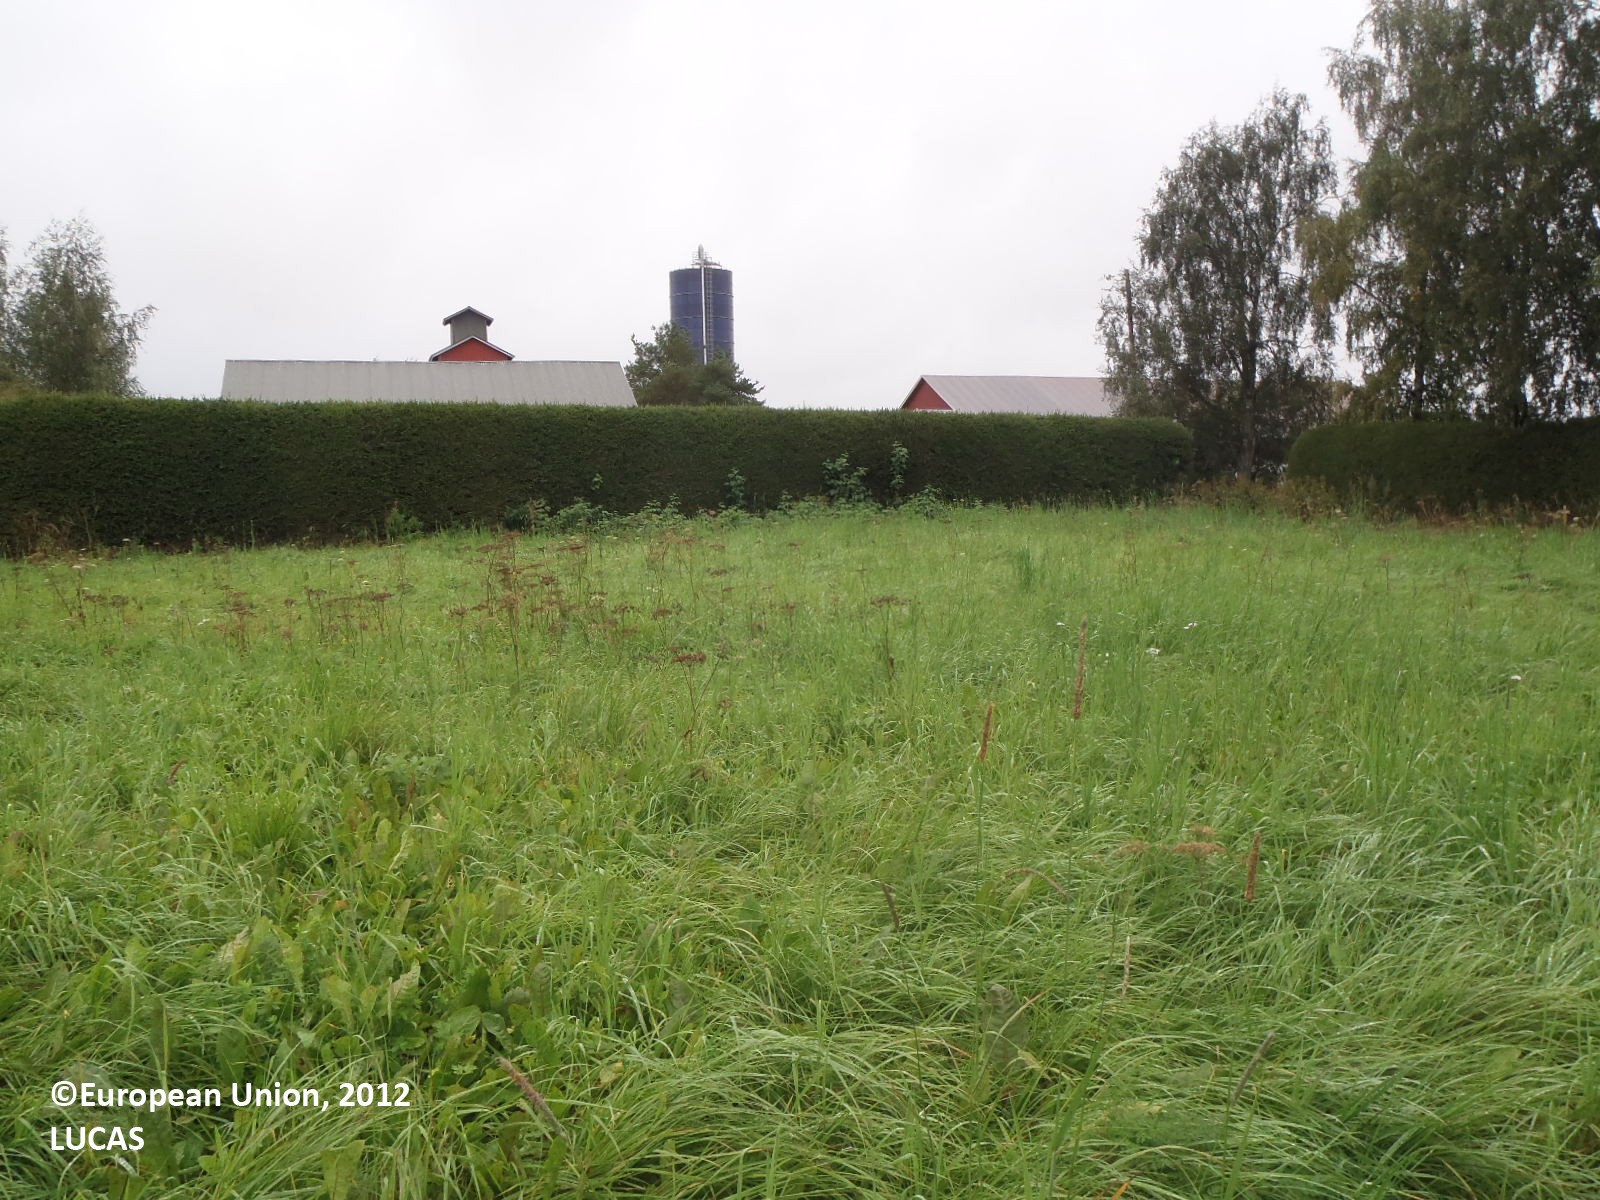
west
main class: Grassland
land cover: Grassland without tree/shrub cover
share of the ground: > 75 %
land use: Agriculture (excluding fallow land and kitchen gardens)
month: September
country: FI
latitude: 61.0315
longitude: 22.6741
